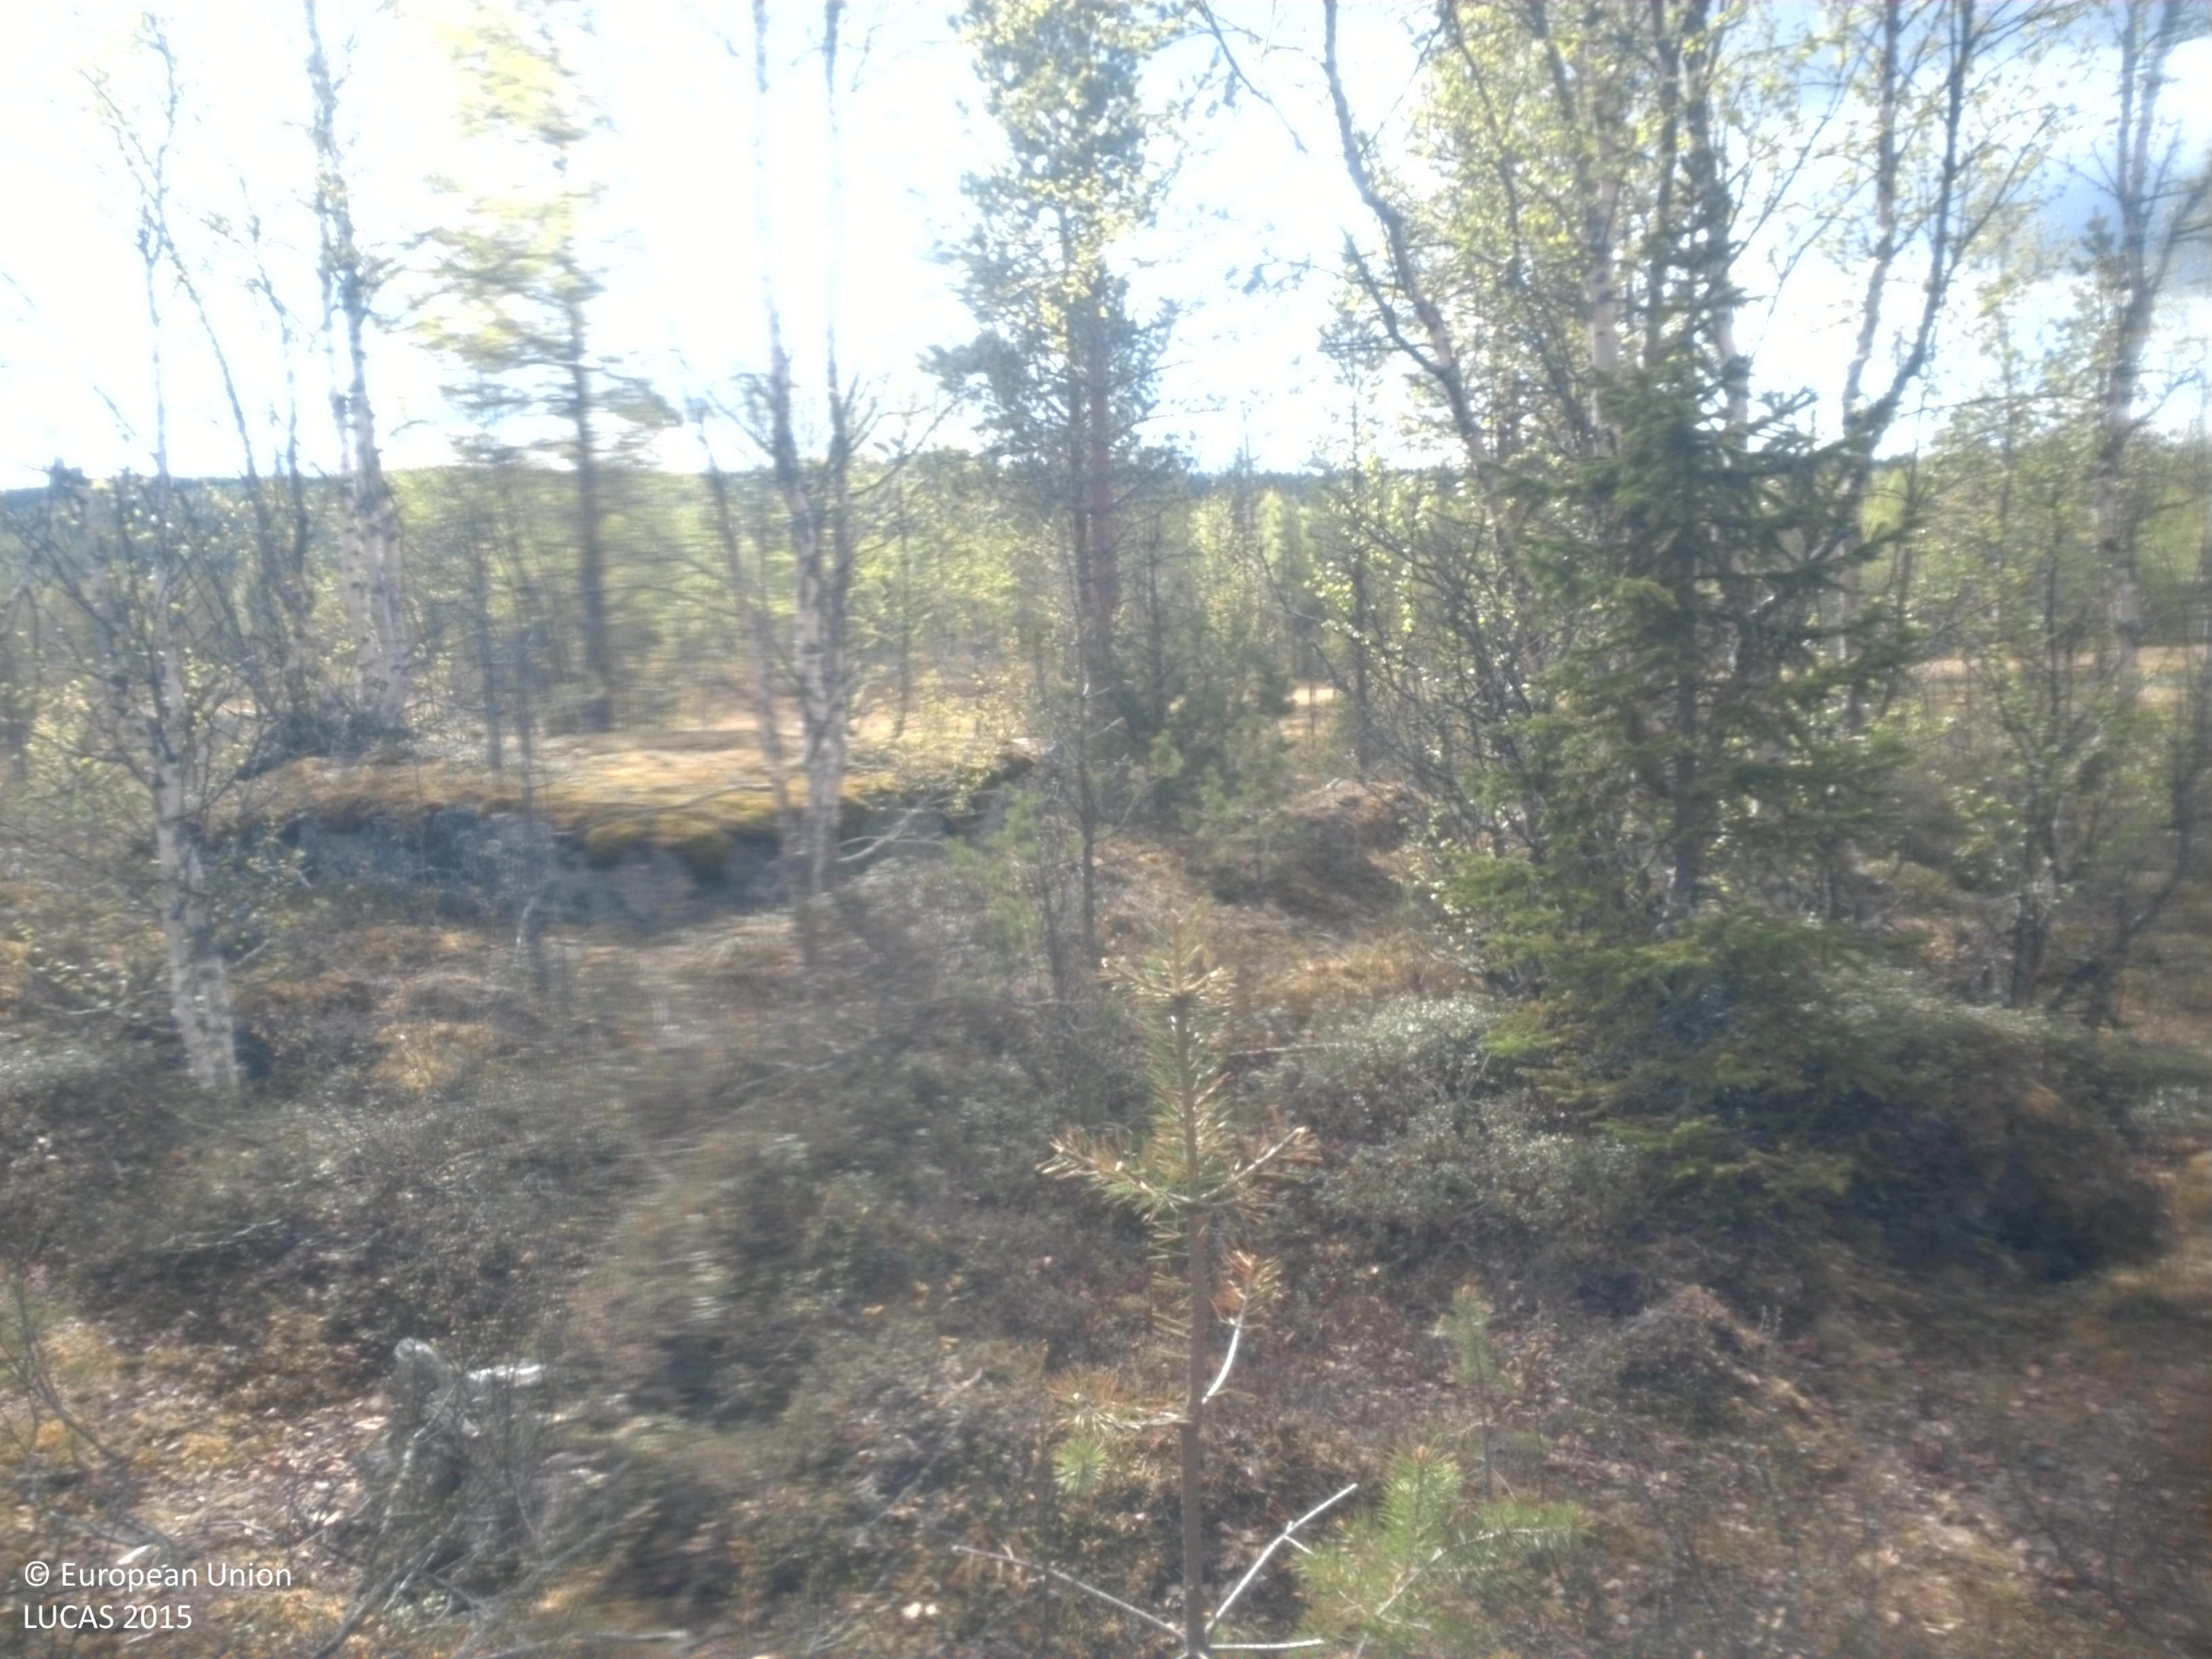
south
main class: Woodland
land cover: Pine dominated mixed woodland
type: boreal forest
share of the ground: 10 - 25 %
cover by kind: shrubs 60 %, herbaceous plants 15 %, coniferous forest trees 10 %, lichens and mosses 10 %, broadleaved forest trees 5 %
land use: Forestry
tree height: < 5 m
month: June
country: SE
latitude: 64.2152
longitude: 17.9847
